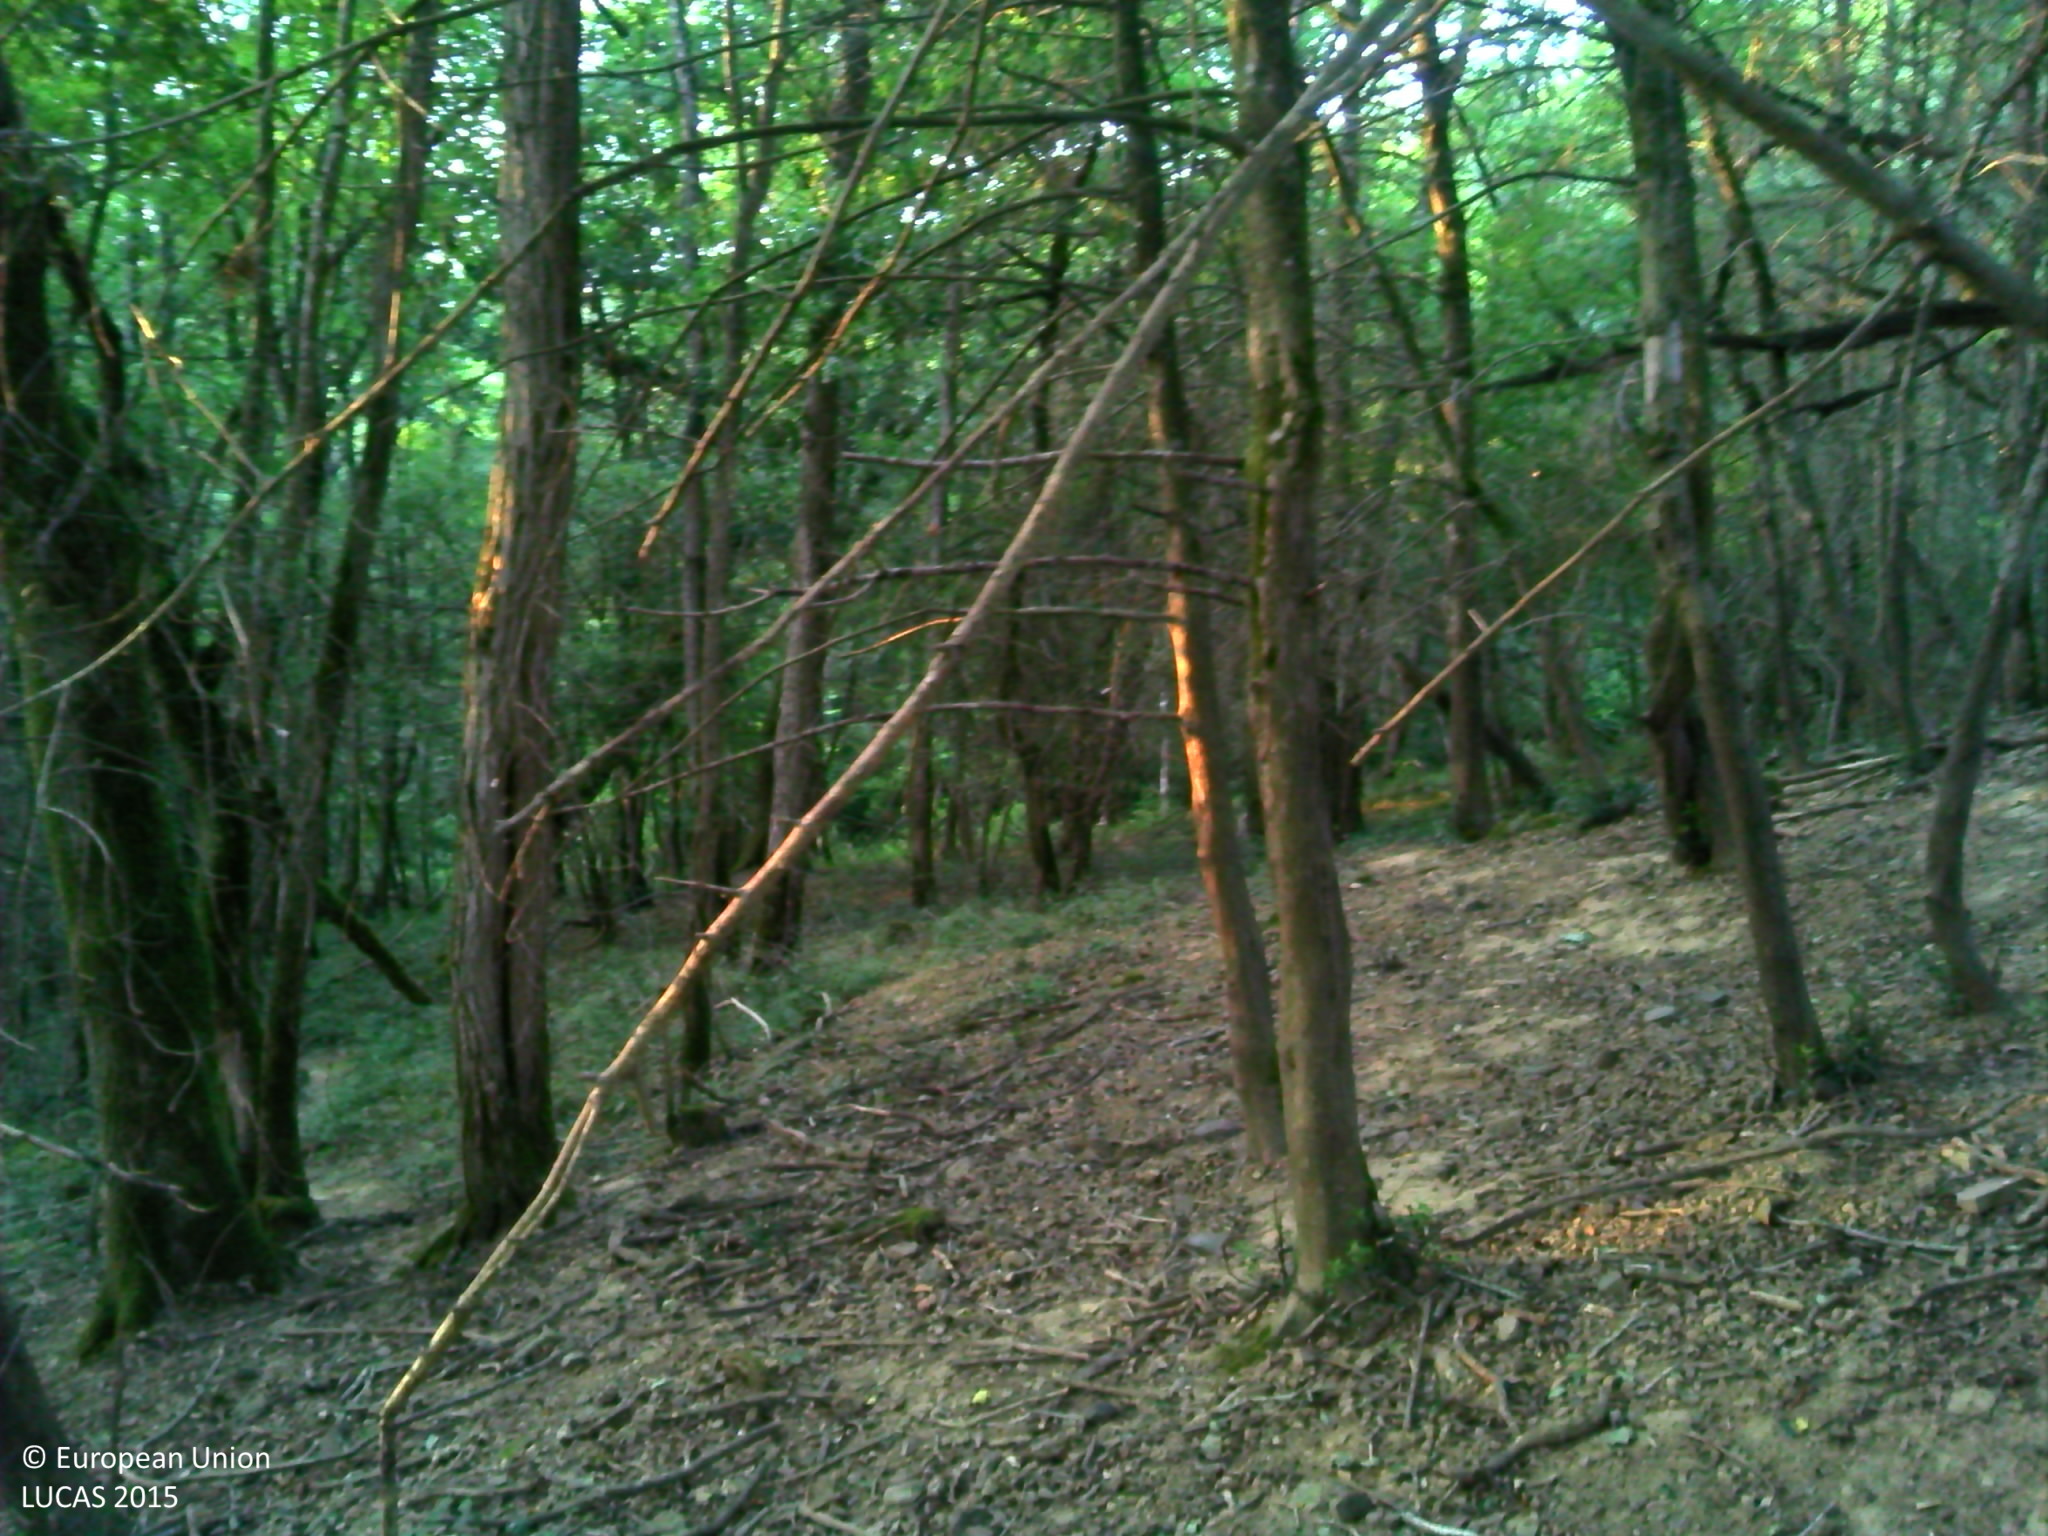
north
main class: Woodland
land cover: Broadleaved woodland
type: thermophilous deciduous forest
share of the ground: > 75 %
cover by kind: broadleaved forest trees 90 %, unconsolidated bare surface 10 %
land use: Forestry
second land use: Agriculture (excluding fallow land and kitchen gardens)
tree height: > 5 m
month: August
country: FR
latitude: 43.4289
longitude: -1.0697
